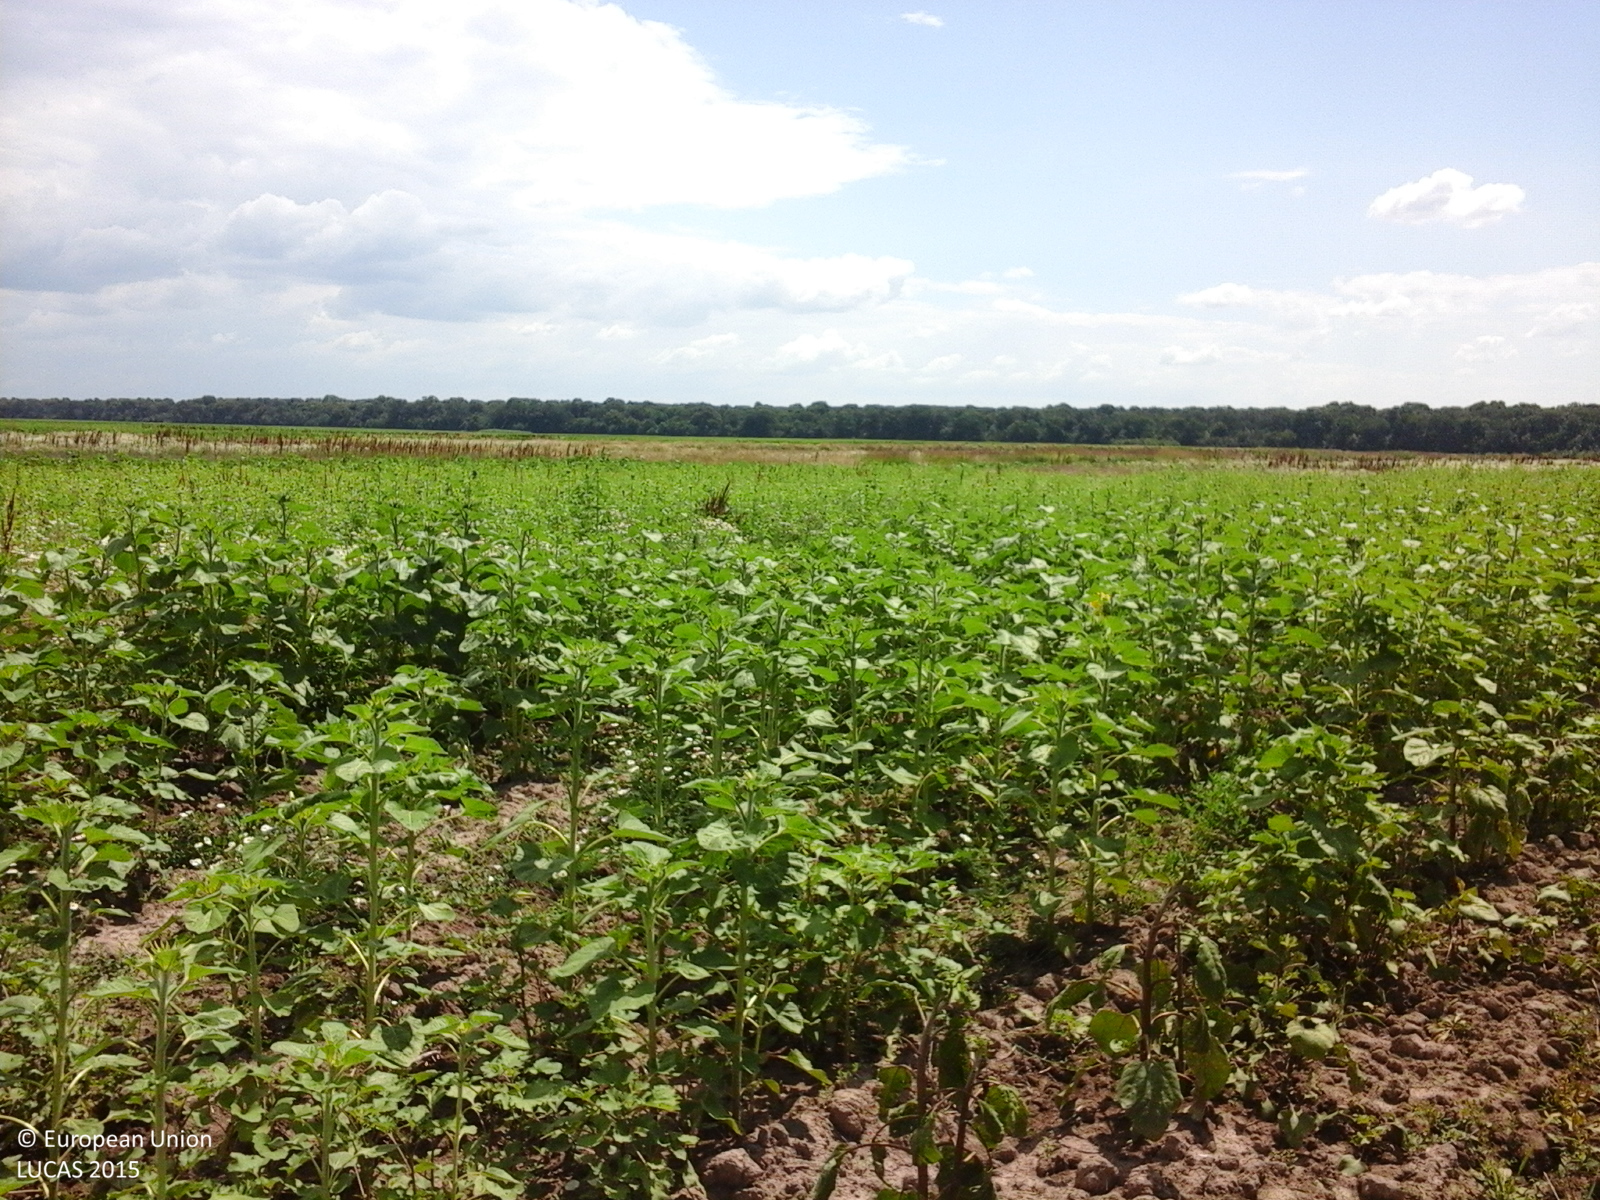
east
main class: Cropland
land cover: Sunflower
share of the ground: 50 - 75 %
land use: Agriculture (excluding fallow land and kitchen gardens)
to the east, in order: Sunflower; Spontaneously vegetated surfaces; Tracks; Spontaneously vegetated surfaces; Sunflower; Spontaneously vegetated surfaces
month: July
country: RO
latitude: 44.3914
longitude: 25.5967
